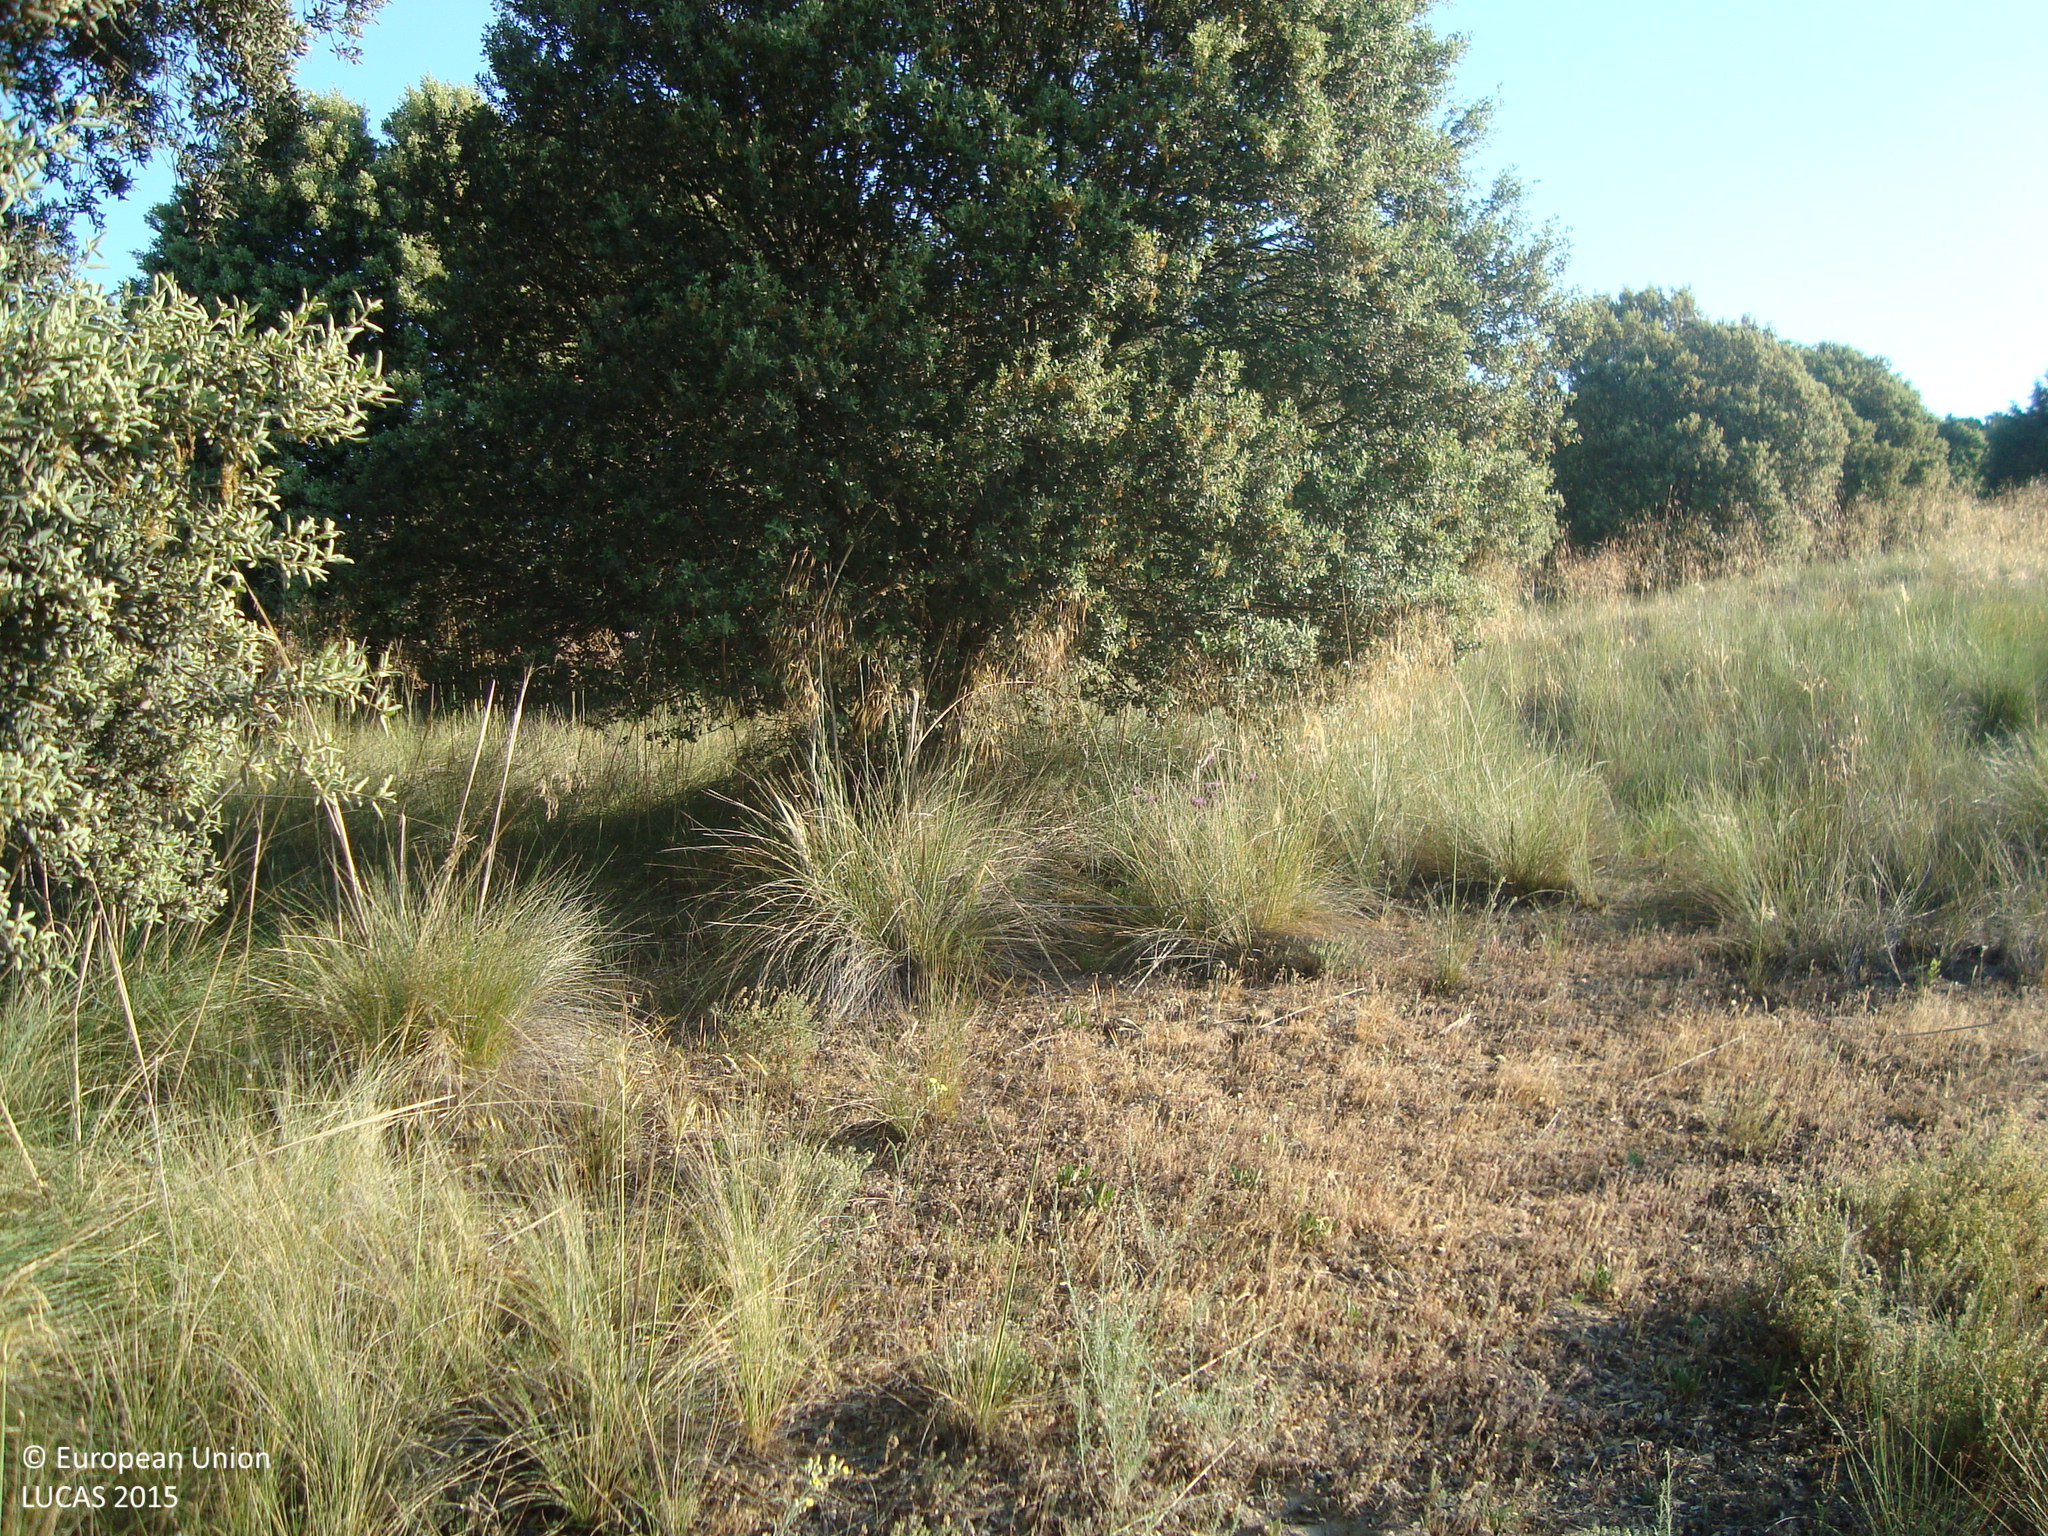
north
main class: Woodland
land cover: Broadleaved woodland
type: broadleaved evergreen forest
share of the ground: 10 - 25 %
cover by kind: herbaceous plants 70 %, broadleaved forest trees 15 %, unconsolidated bare surface 10 %, shrubs 5 %
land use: Abandoned areas
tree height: > 5 m
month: June
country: ES
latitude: 41.7462
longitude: -3.6292
